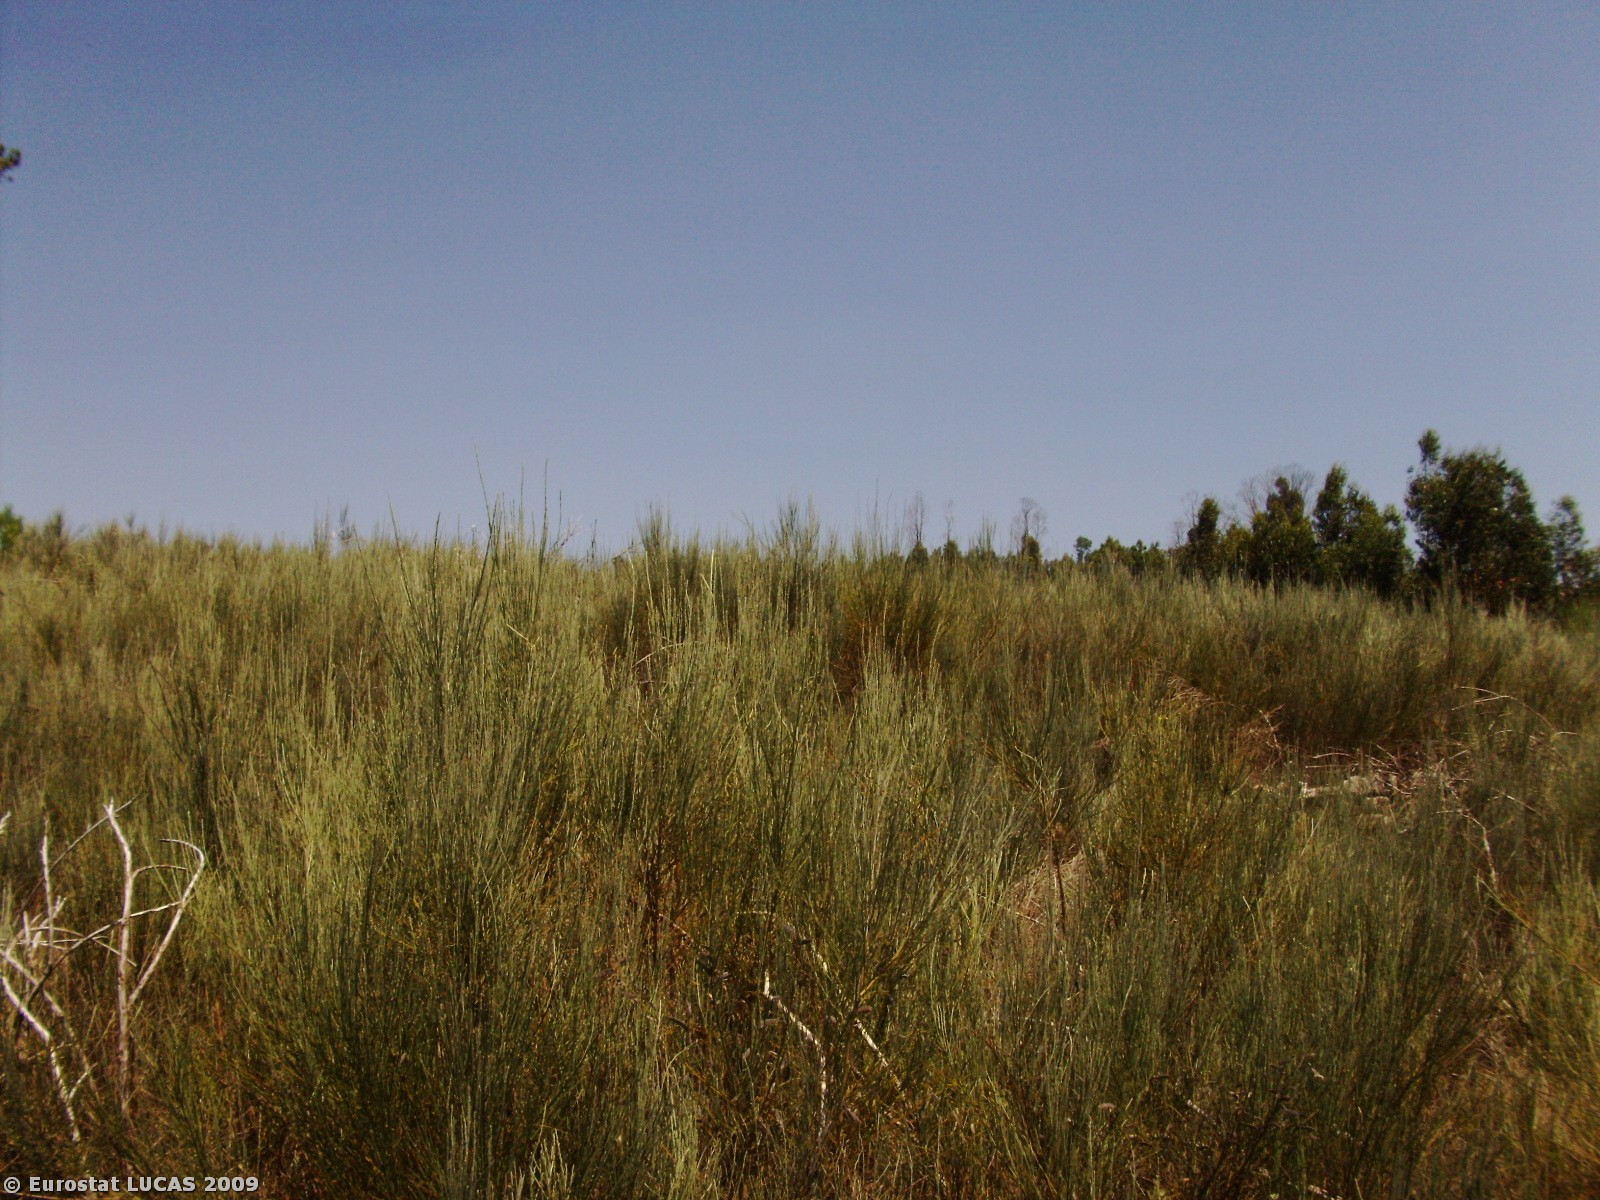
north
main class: Shrubland
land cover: Shrubland without tree cover
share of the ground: > 75 %
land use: Unused
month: July
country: PT
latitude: 40.6501
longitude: -7.6314
